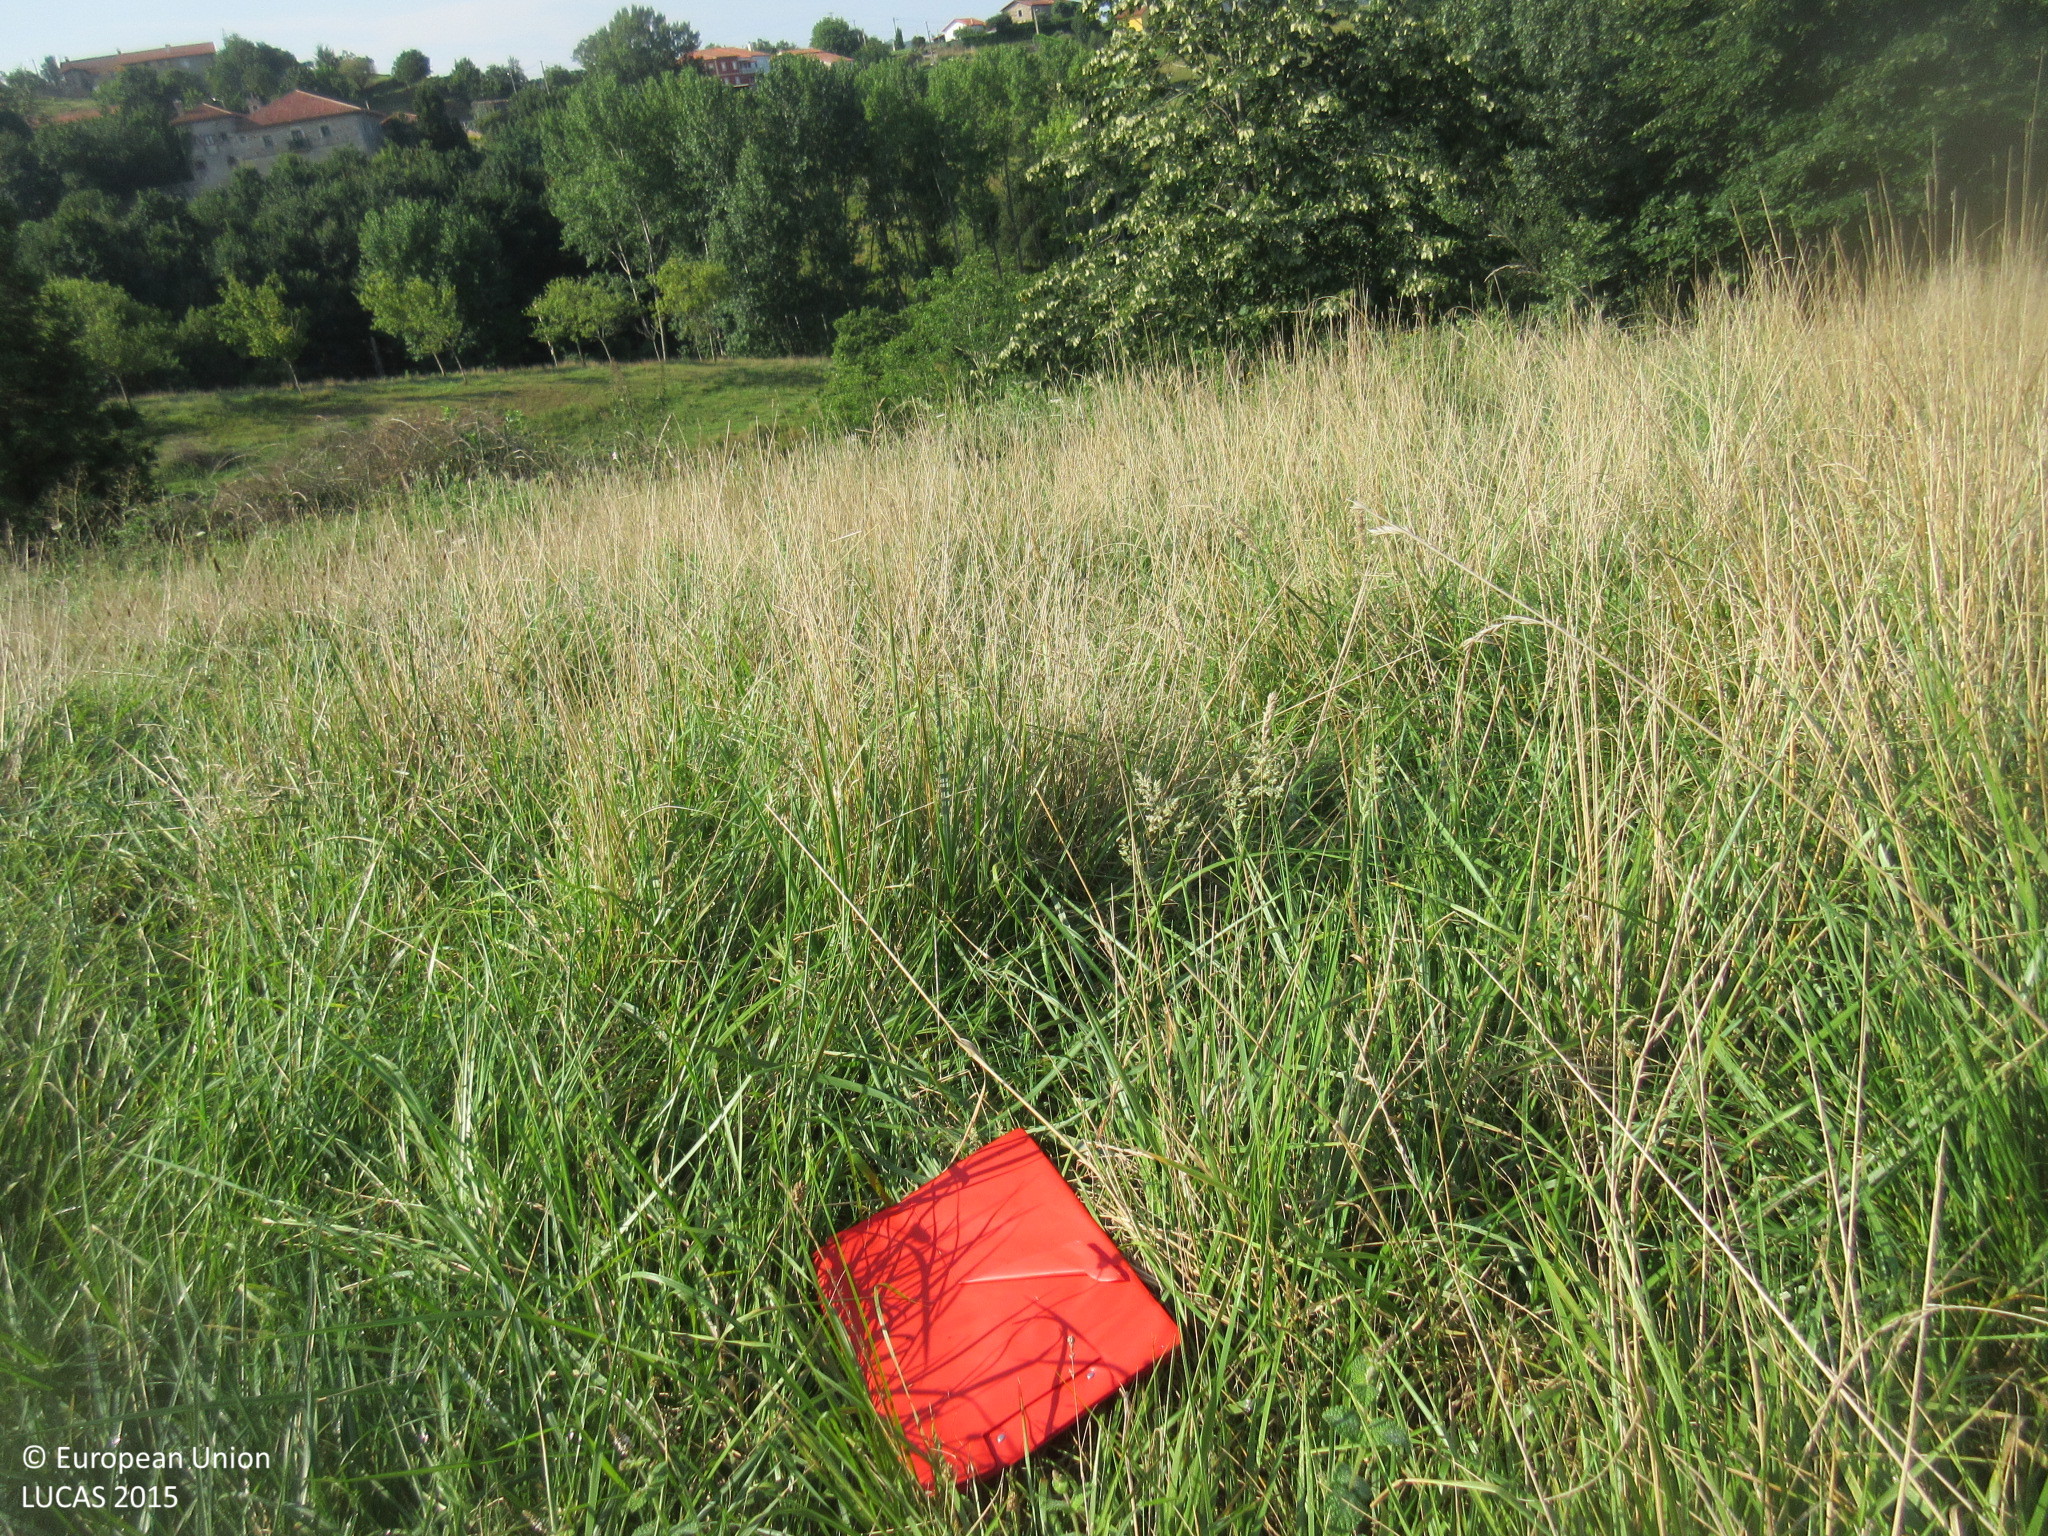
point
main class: Grassland
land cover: Grassland without tree/shrub cover
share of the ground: > 75 %
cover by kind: herbaceous plants 100 %
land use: Agriculture (excluding fallow land and kitchen gardens)
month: July
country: ES
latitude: 43.3973
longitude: -3.9909
